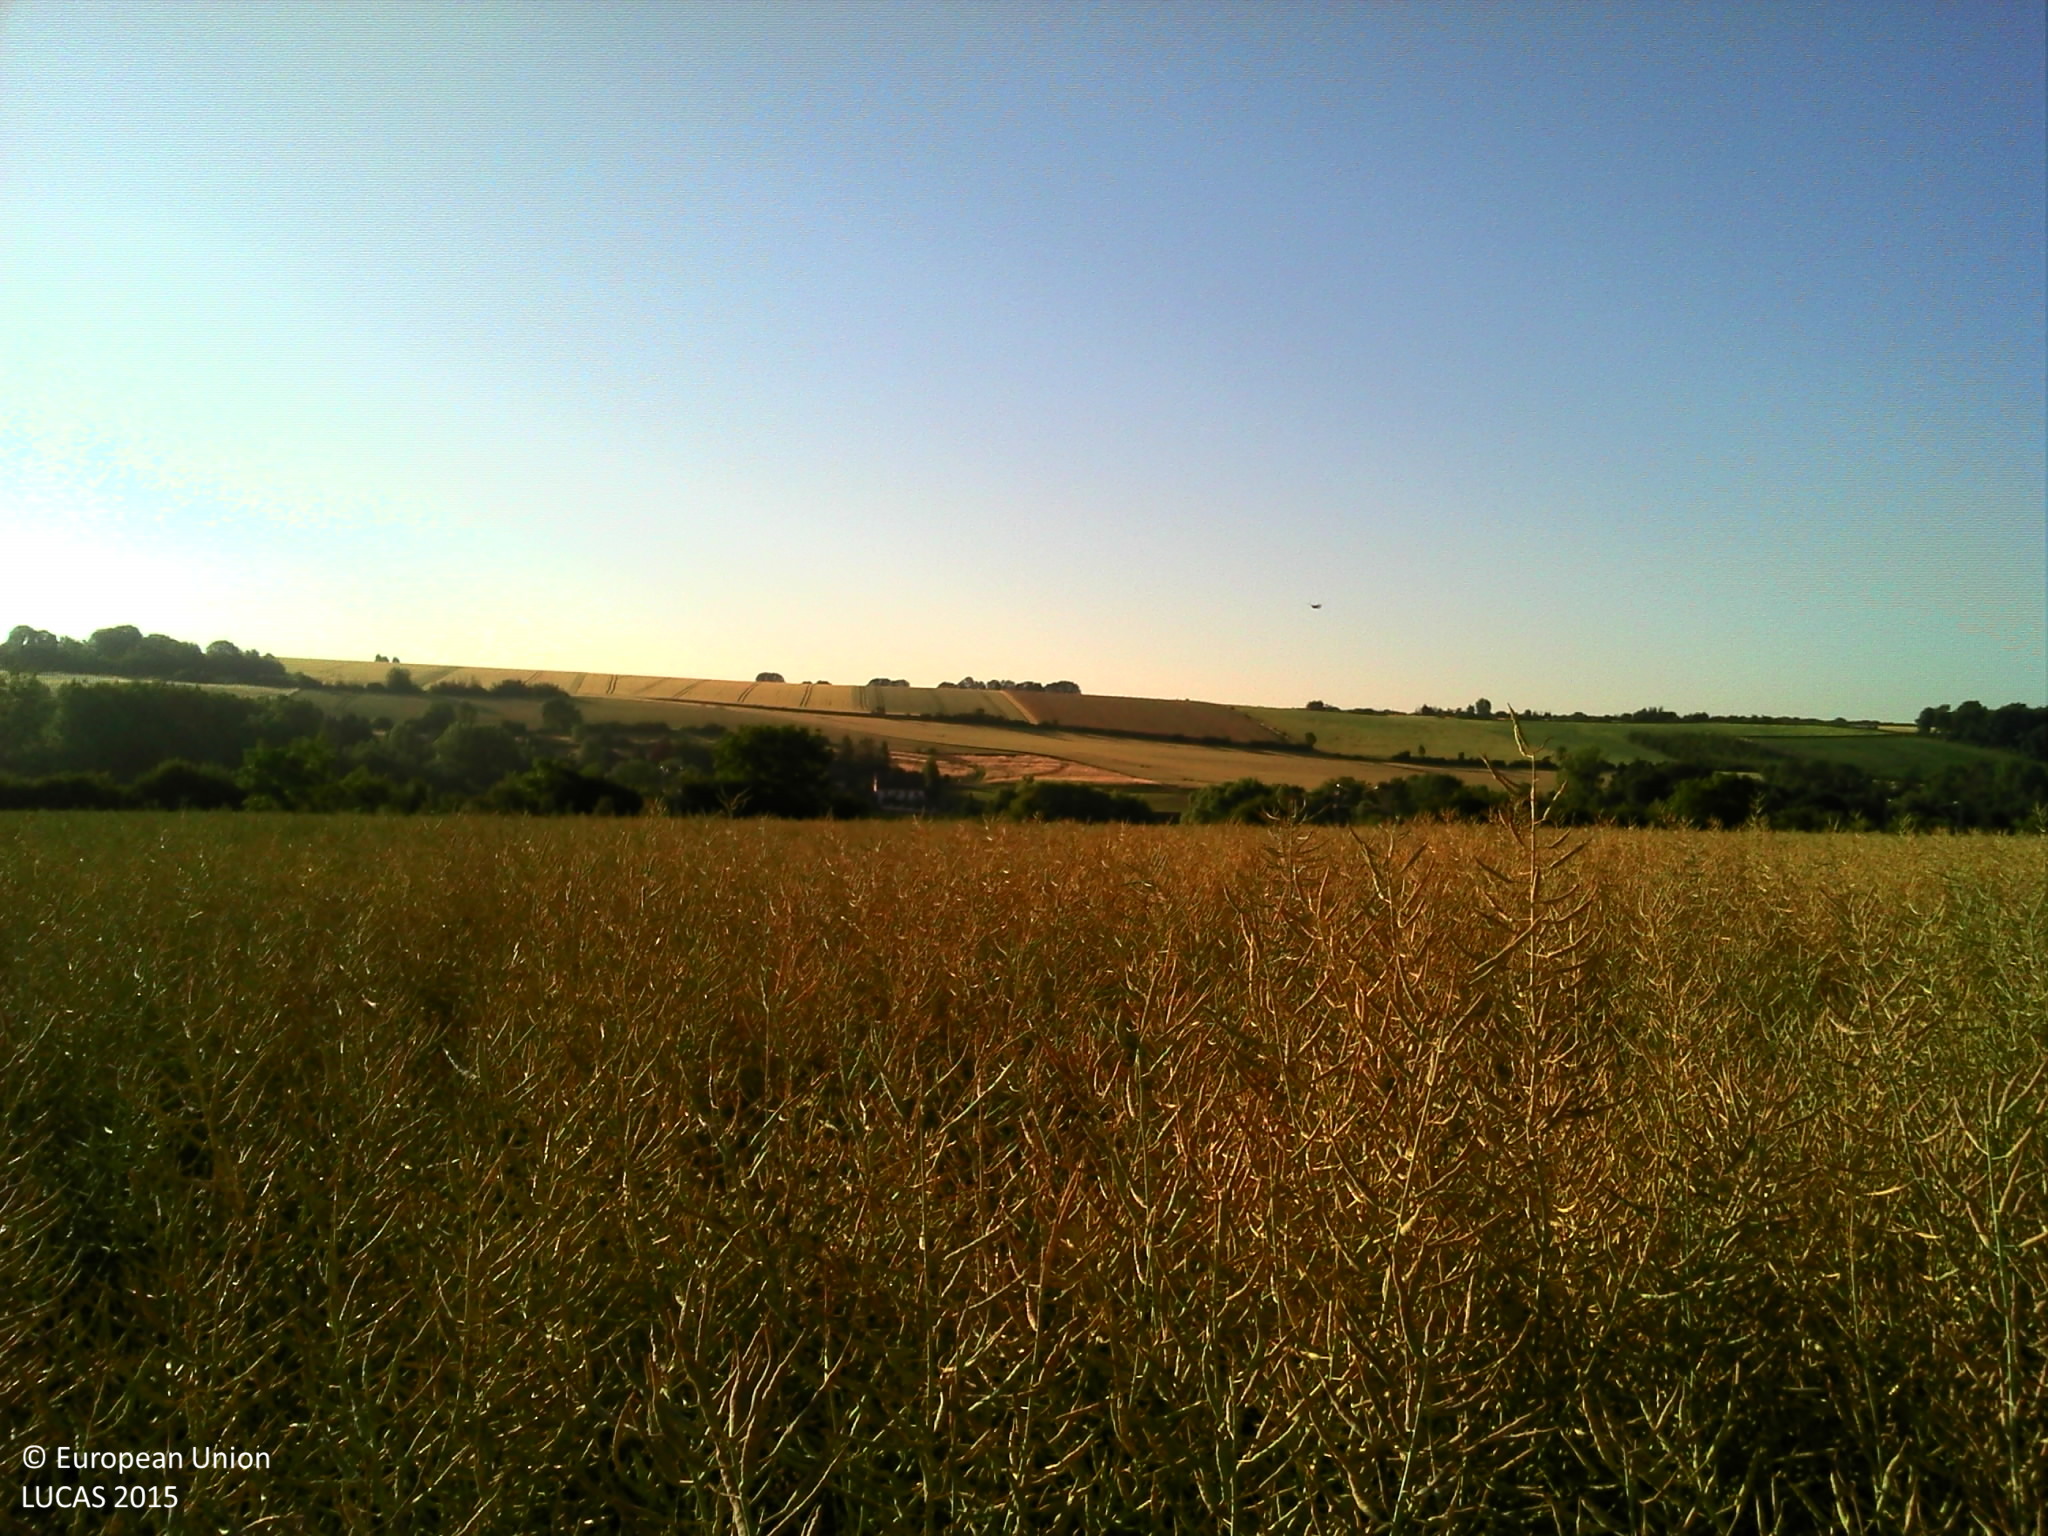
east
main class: Cropland
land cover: Rape and turnip rape
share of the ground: > 75 %
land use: Agriculture (excluding fallow land and kitchen gardens)
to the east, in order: Rape and turnip rape; Lines of trees; Electric lines; Railways; Grass margins; Lines of trees; Grass margins; Sugar beet
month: June
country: FR
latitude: 49.4437
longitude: 2.4157
